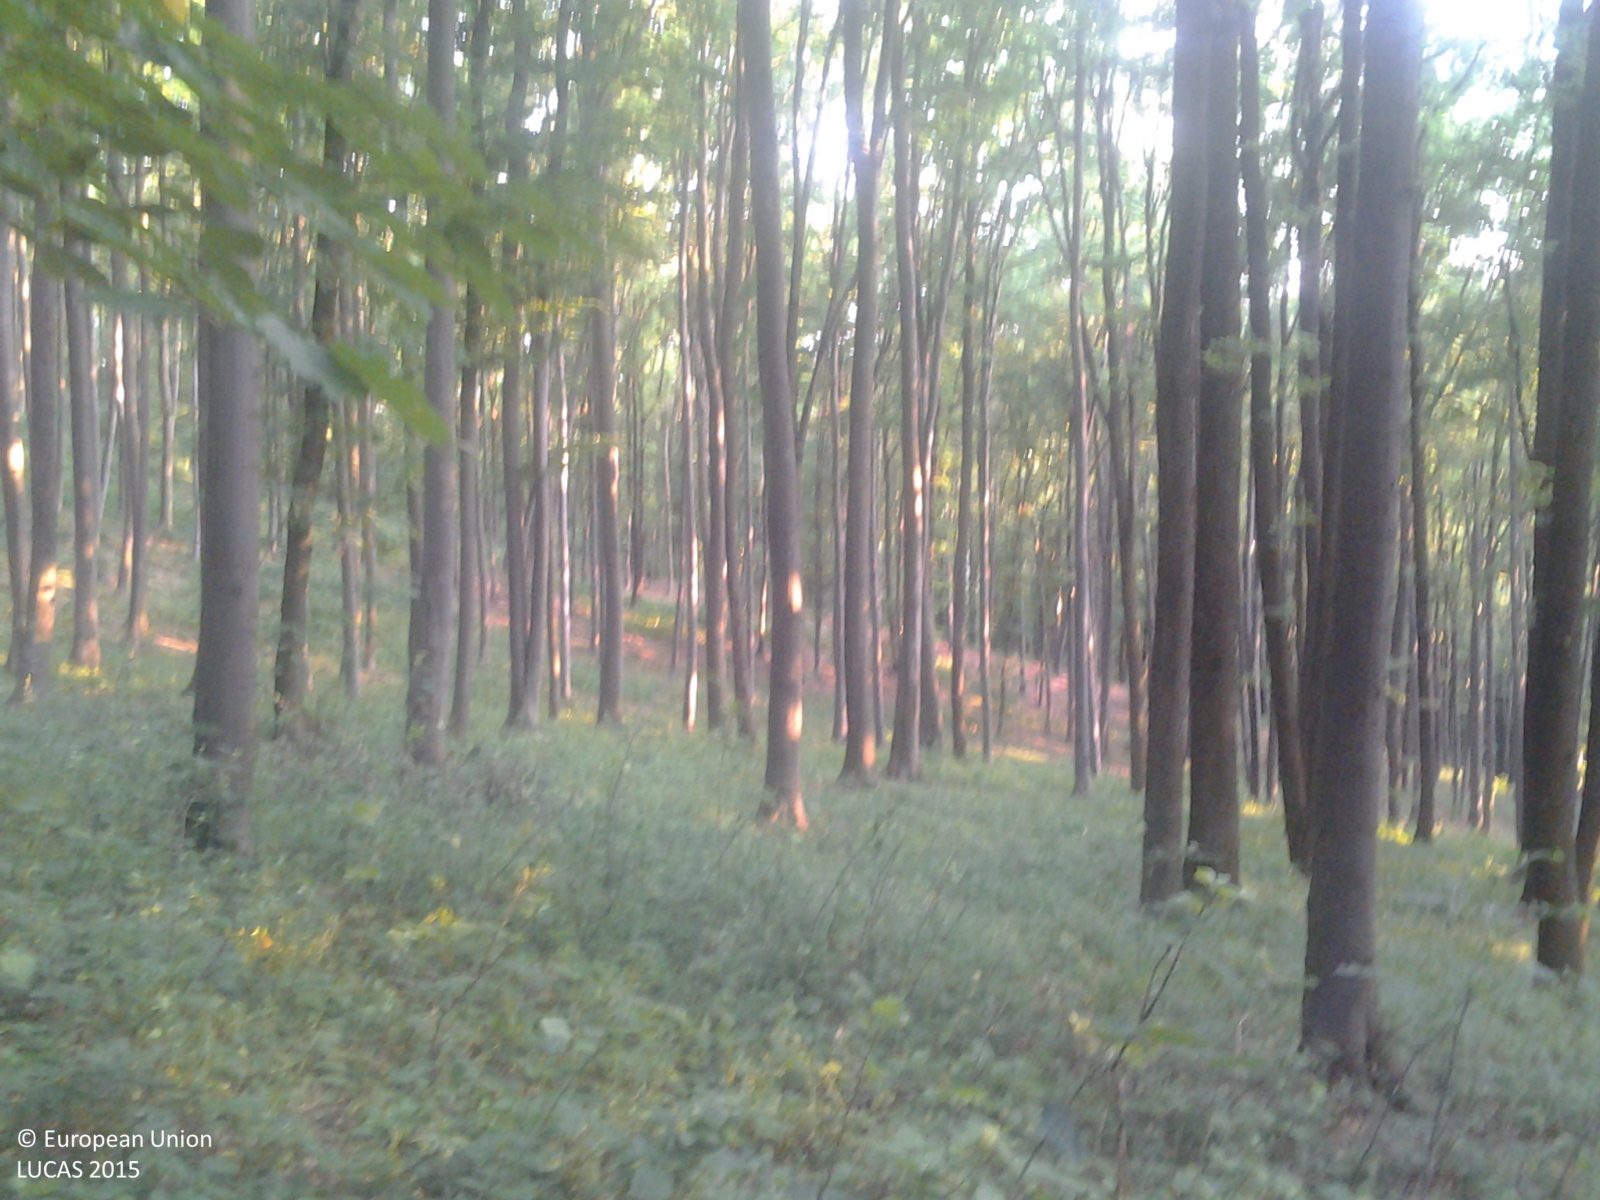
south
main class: Woodland
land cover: Broadleaved woodland
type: beech forest
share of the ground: > 75 %
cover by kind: broadleaved forest trees 100 %
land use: Forestry
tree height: > 5 m
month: June
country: RO
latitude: 46.3491
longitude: 27.1610
